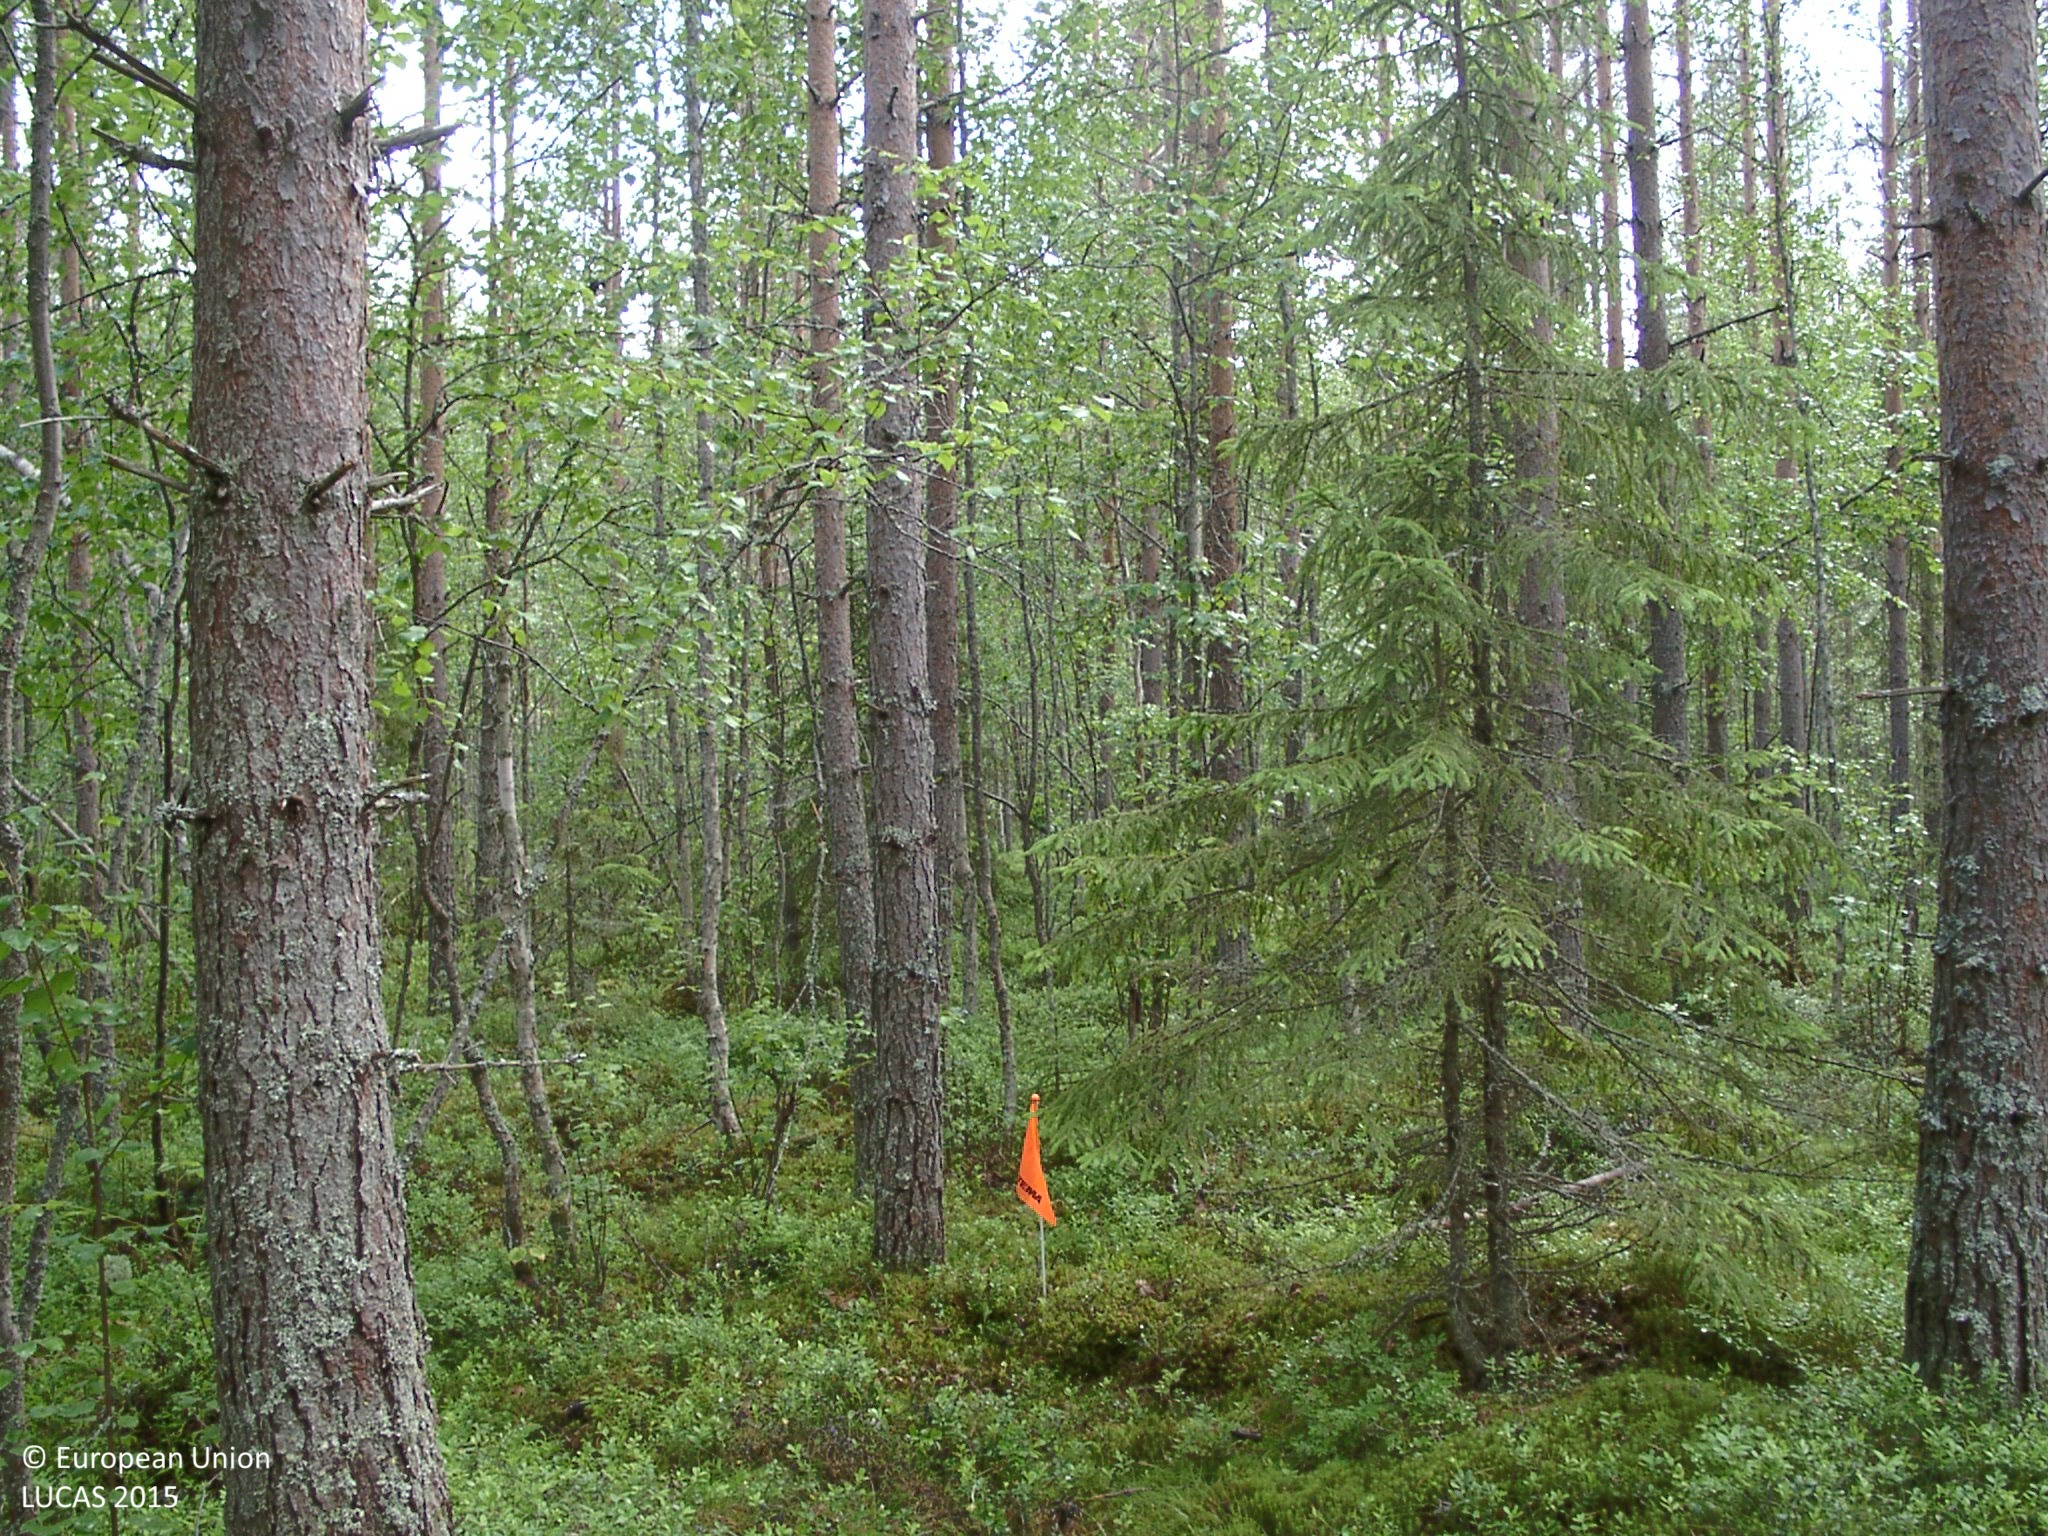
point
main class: Woodland
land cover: Other mixed woodland
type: boreal forest
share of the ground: 50 - 75 %
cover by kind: coniferous forest trees 55 %, broadleaved forest trees 20 %, shrubs 20 %, lichens and mosses 5 %
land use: Semi-natural and natural areas not in use
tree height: > 5 m
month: July
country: FI
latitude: 62.1580
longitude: 25.0955
